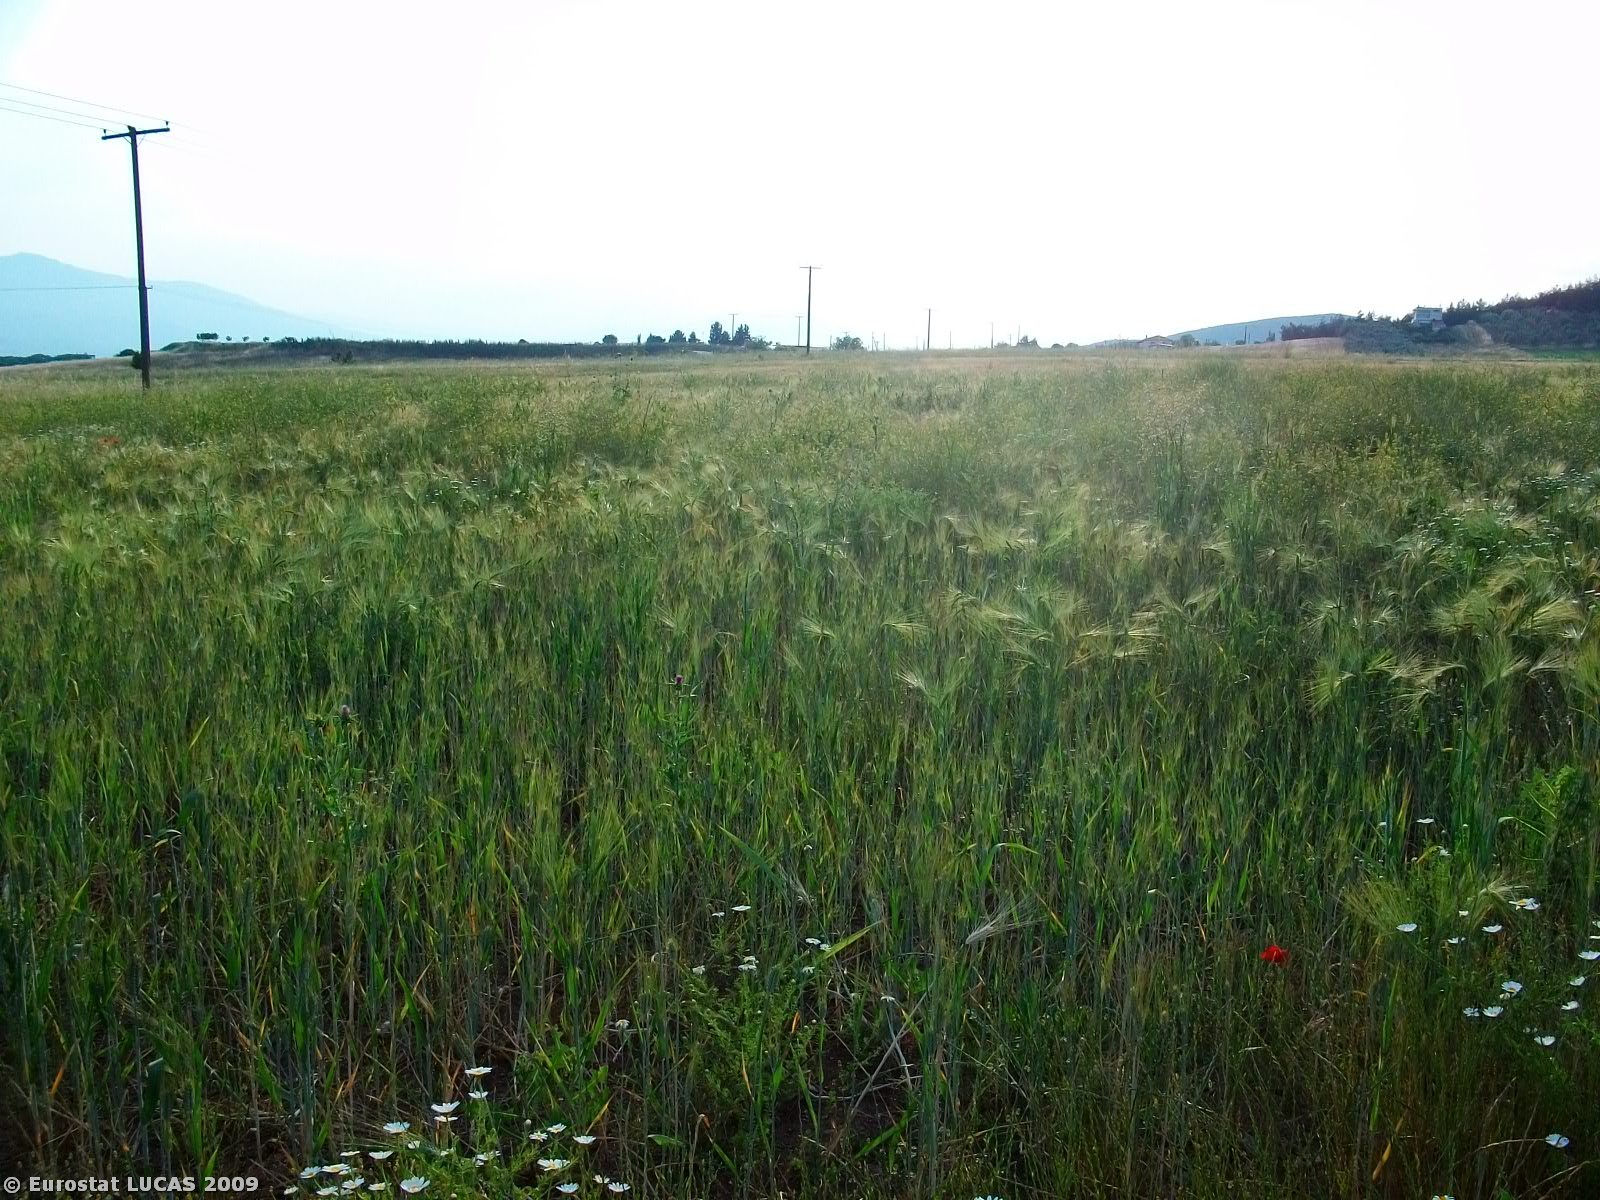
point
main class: Cropland
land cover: Common wheat
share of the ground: > 75 %
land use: Agriculture (excluding fallow land and kitchen gardens)
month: May
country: GR
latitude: 38.9278
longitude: 22.2644
